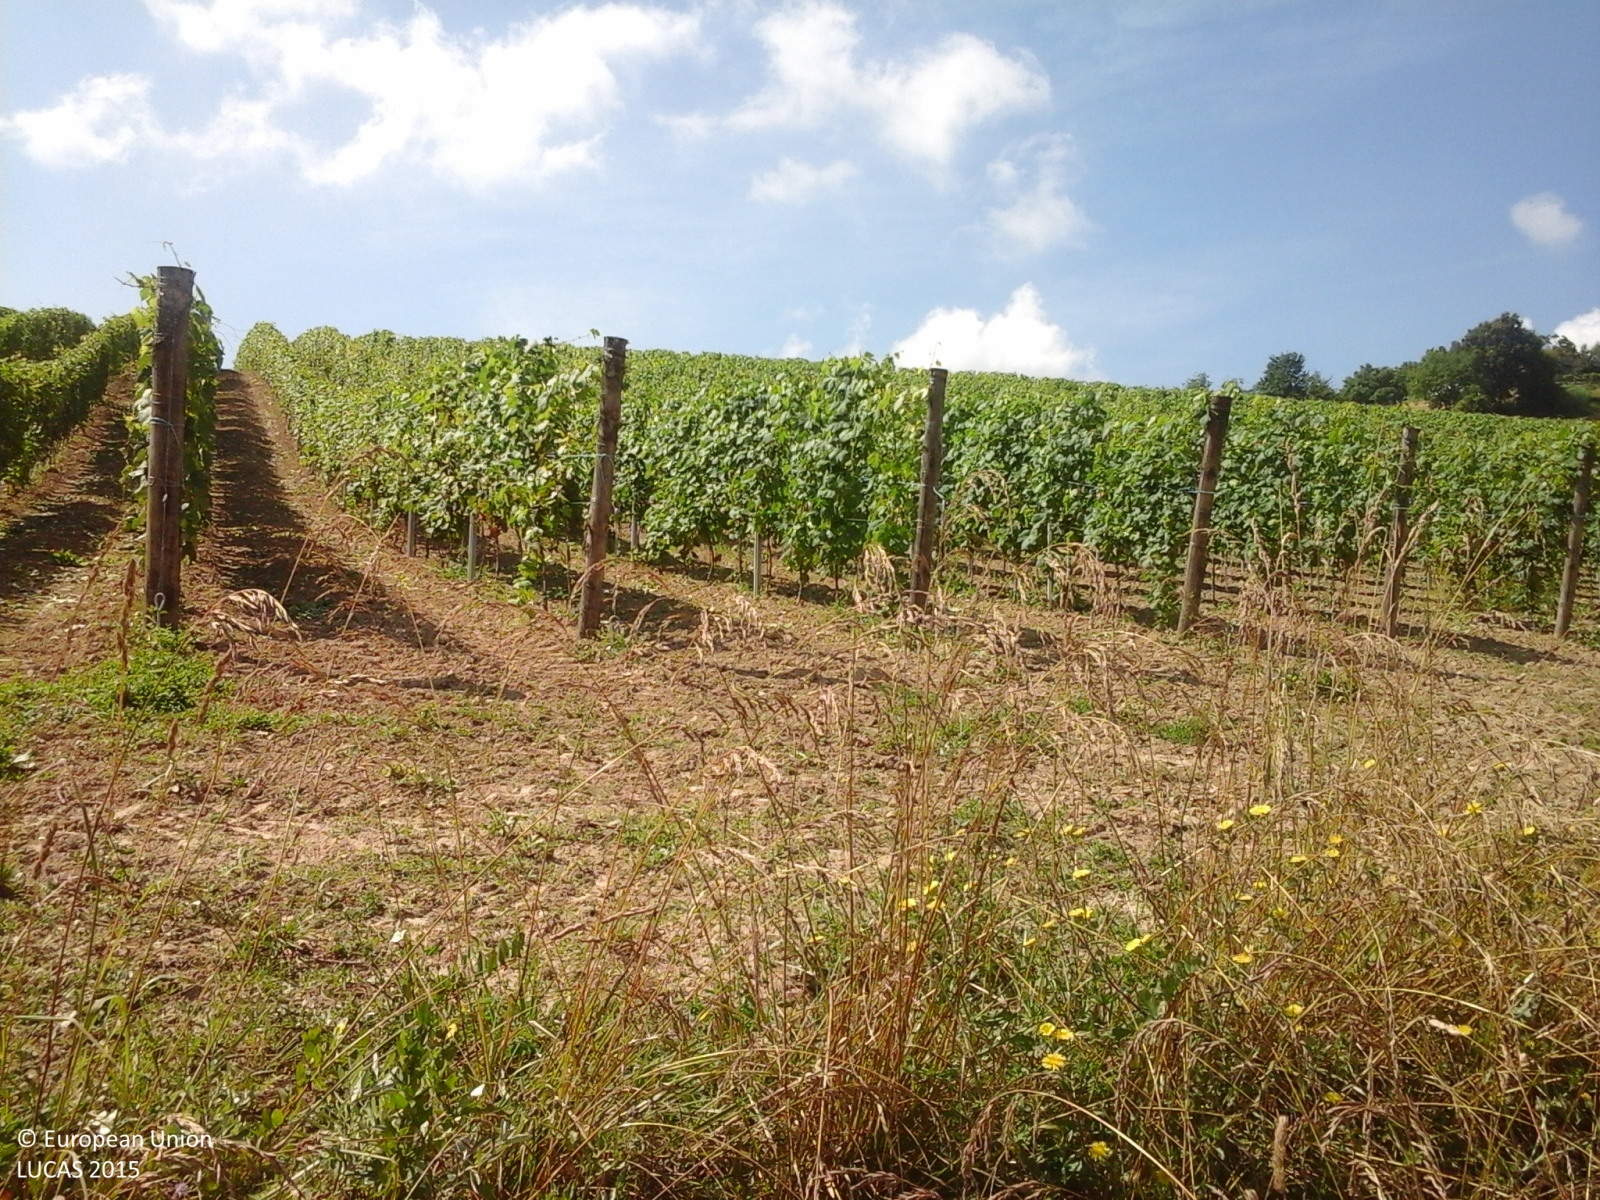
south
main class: Cropland
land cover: Barley
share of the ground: > 75 %
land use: Agriculture (excluding fallow land and kitchen gardens)
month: June
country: IT
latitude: 44.9858
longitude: 8.2911
